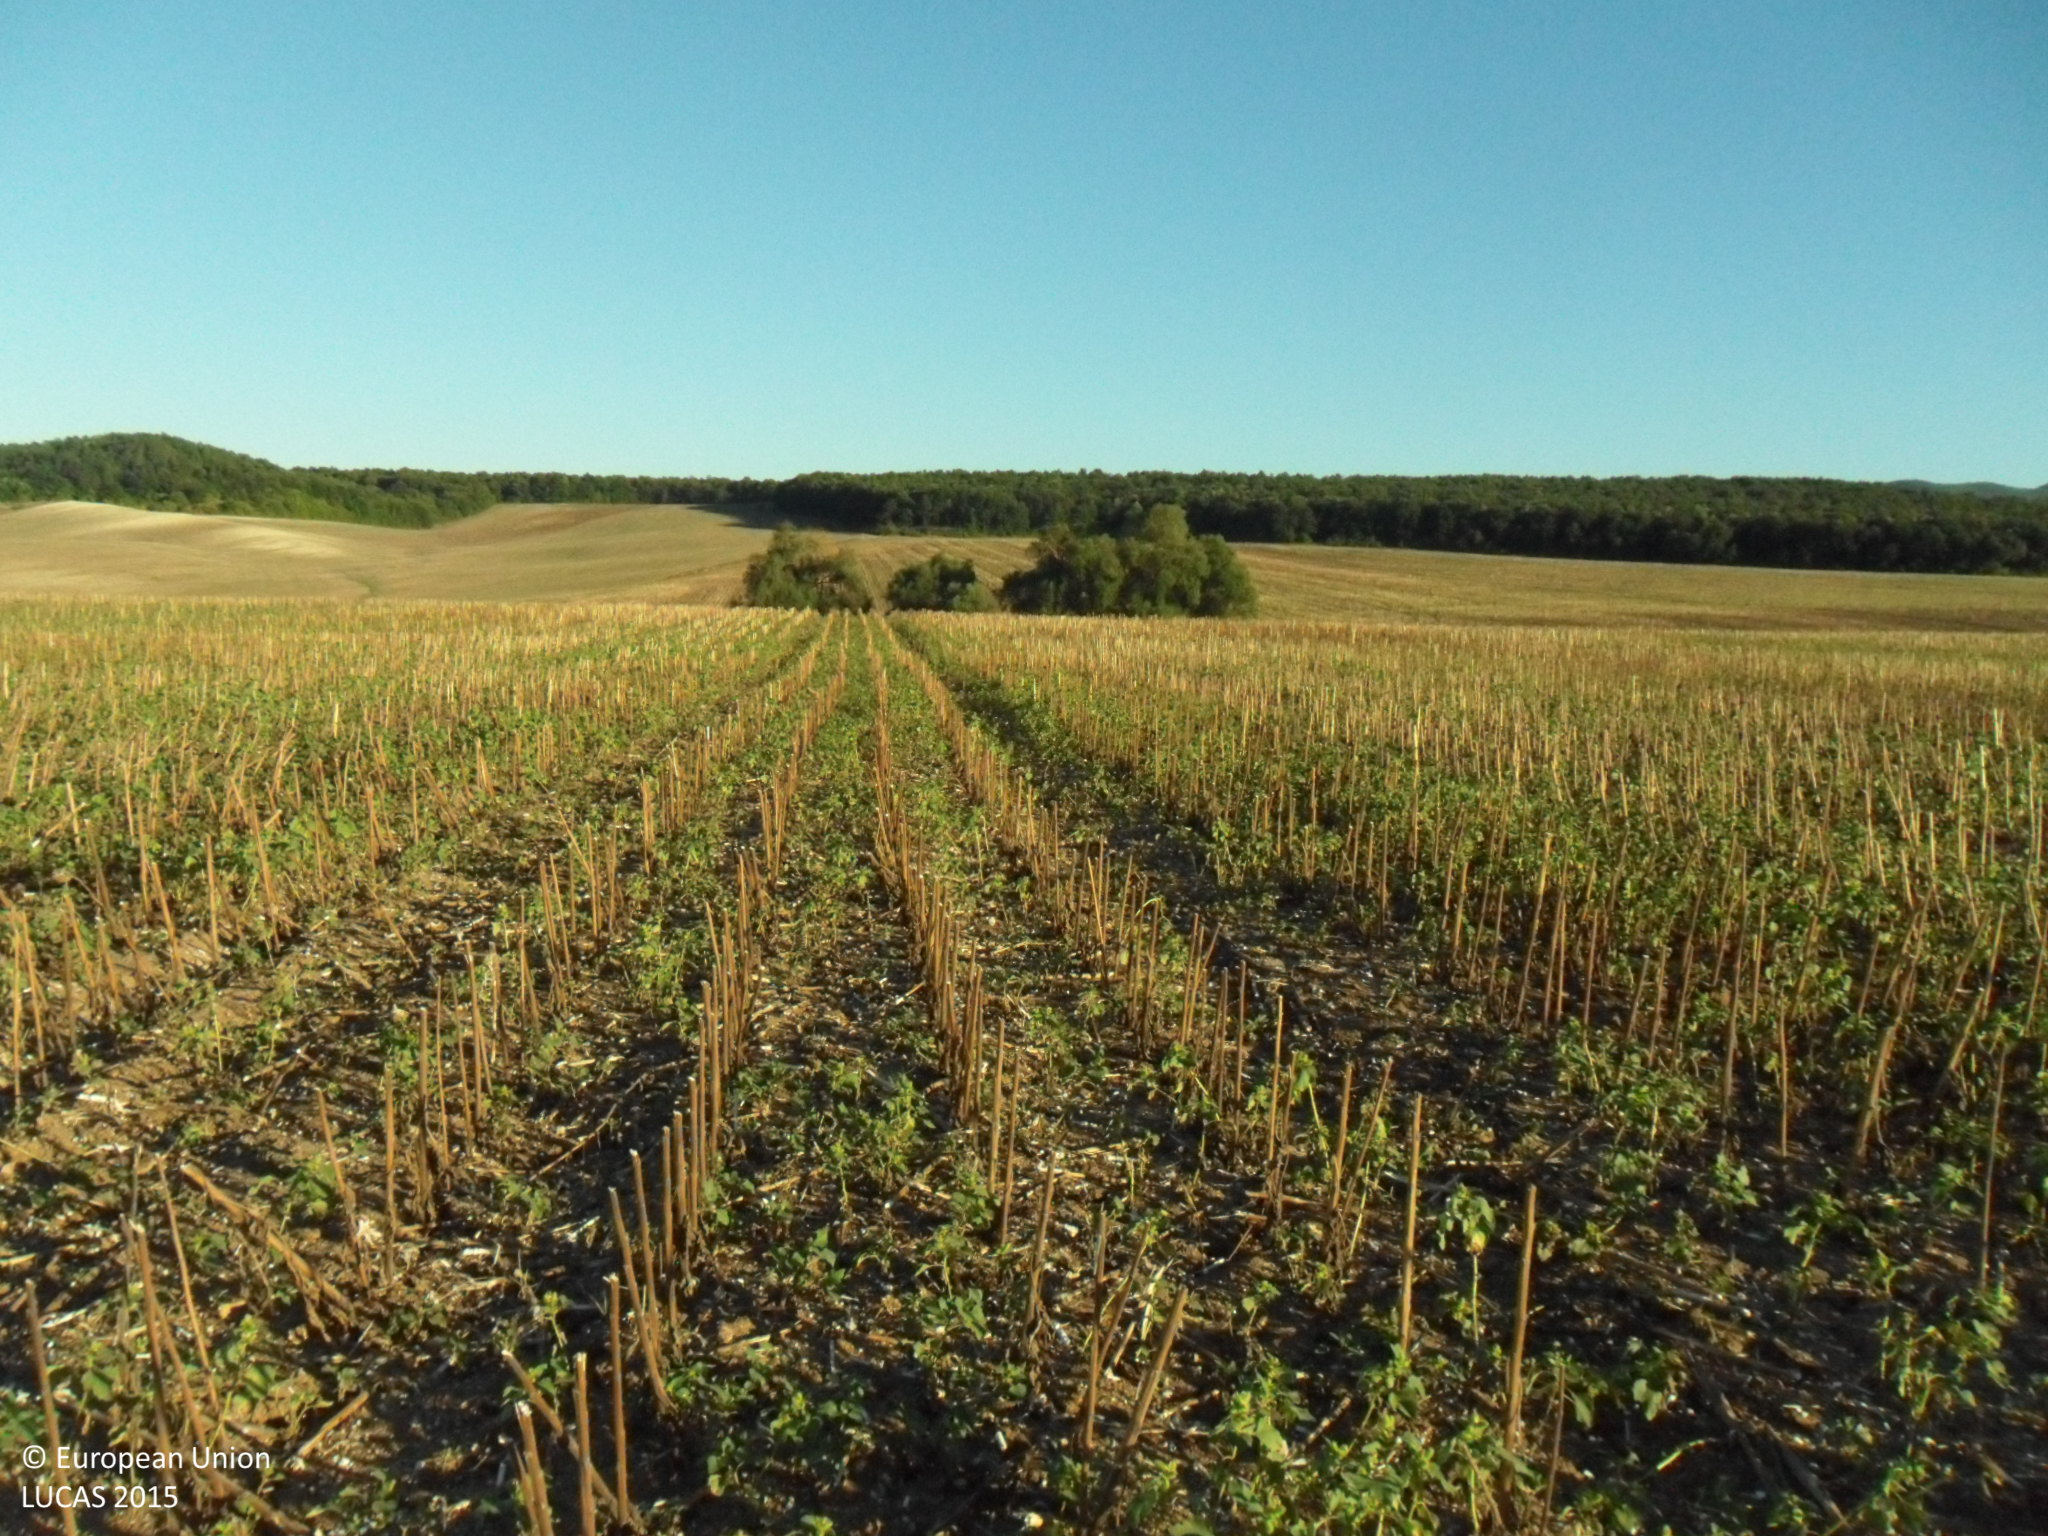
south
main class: Cropland
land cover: Sunflower
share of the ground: 10 - 25 %
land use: Agriculture (excluding fallow land and kitchen gardens)
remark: Harvested field
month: September
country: BG
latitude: 43.1927
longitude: 26.7816
